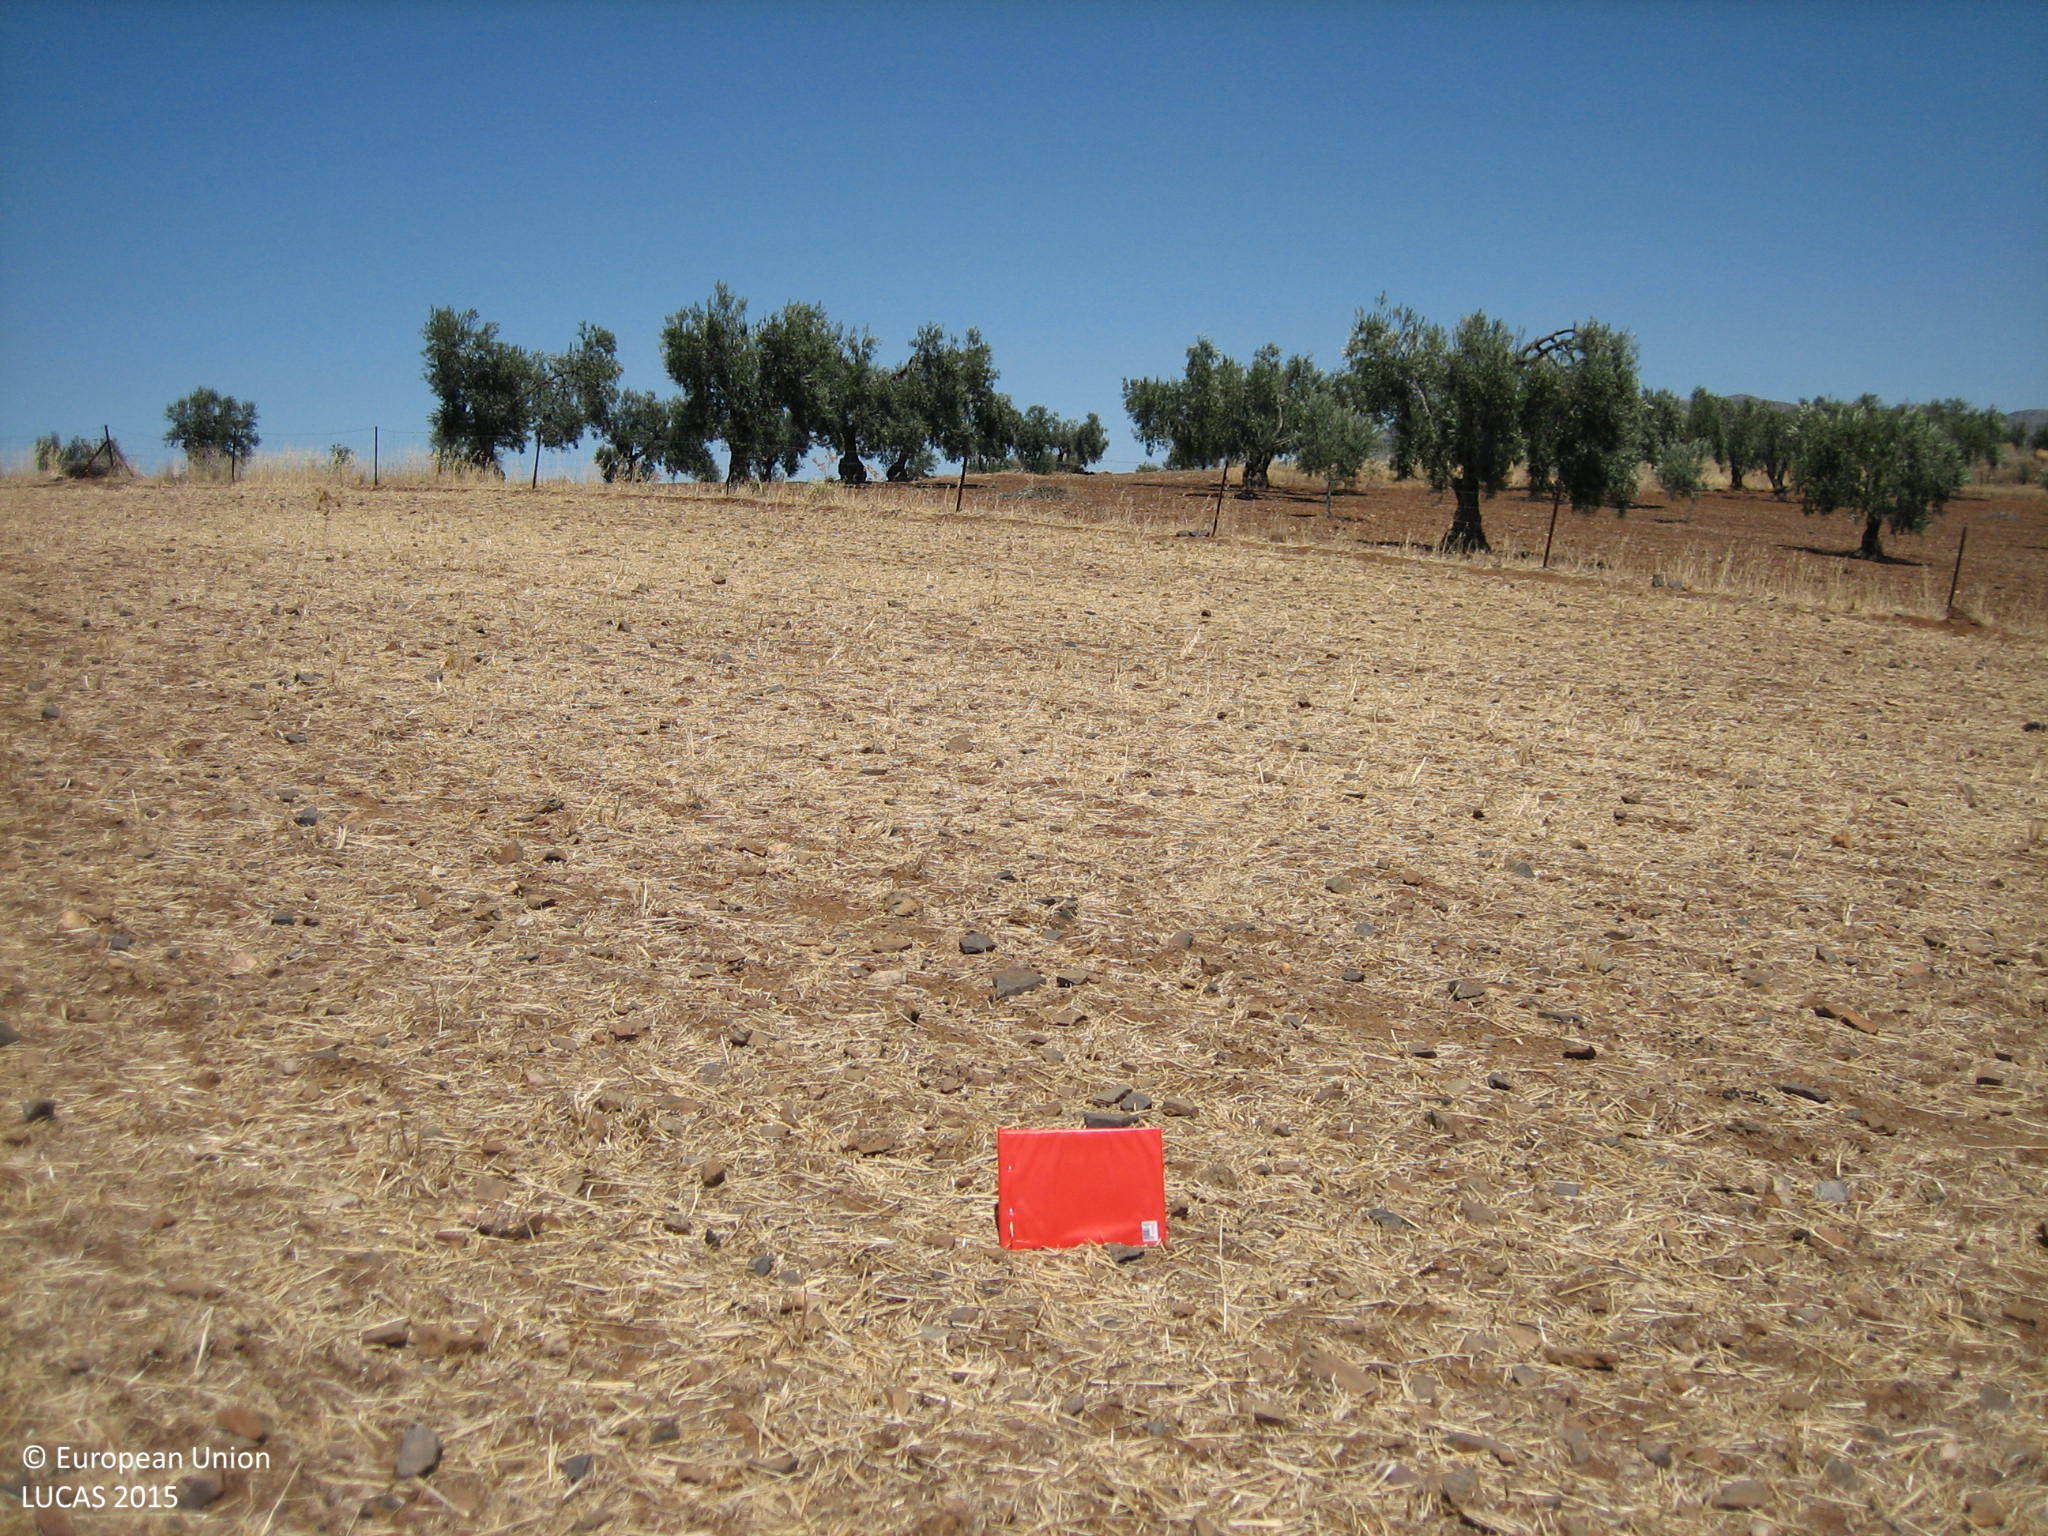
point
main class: Cropland
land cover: Oats
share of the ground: < 10 %
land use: Agriculture (excluding fallow land and kitchen gardens)
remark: Harvested field
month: July
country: ES
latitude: 38.5832
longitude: -6.1775
